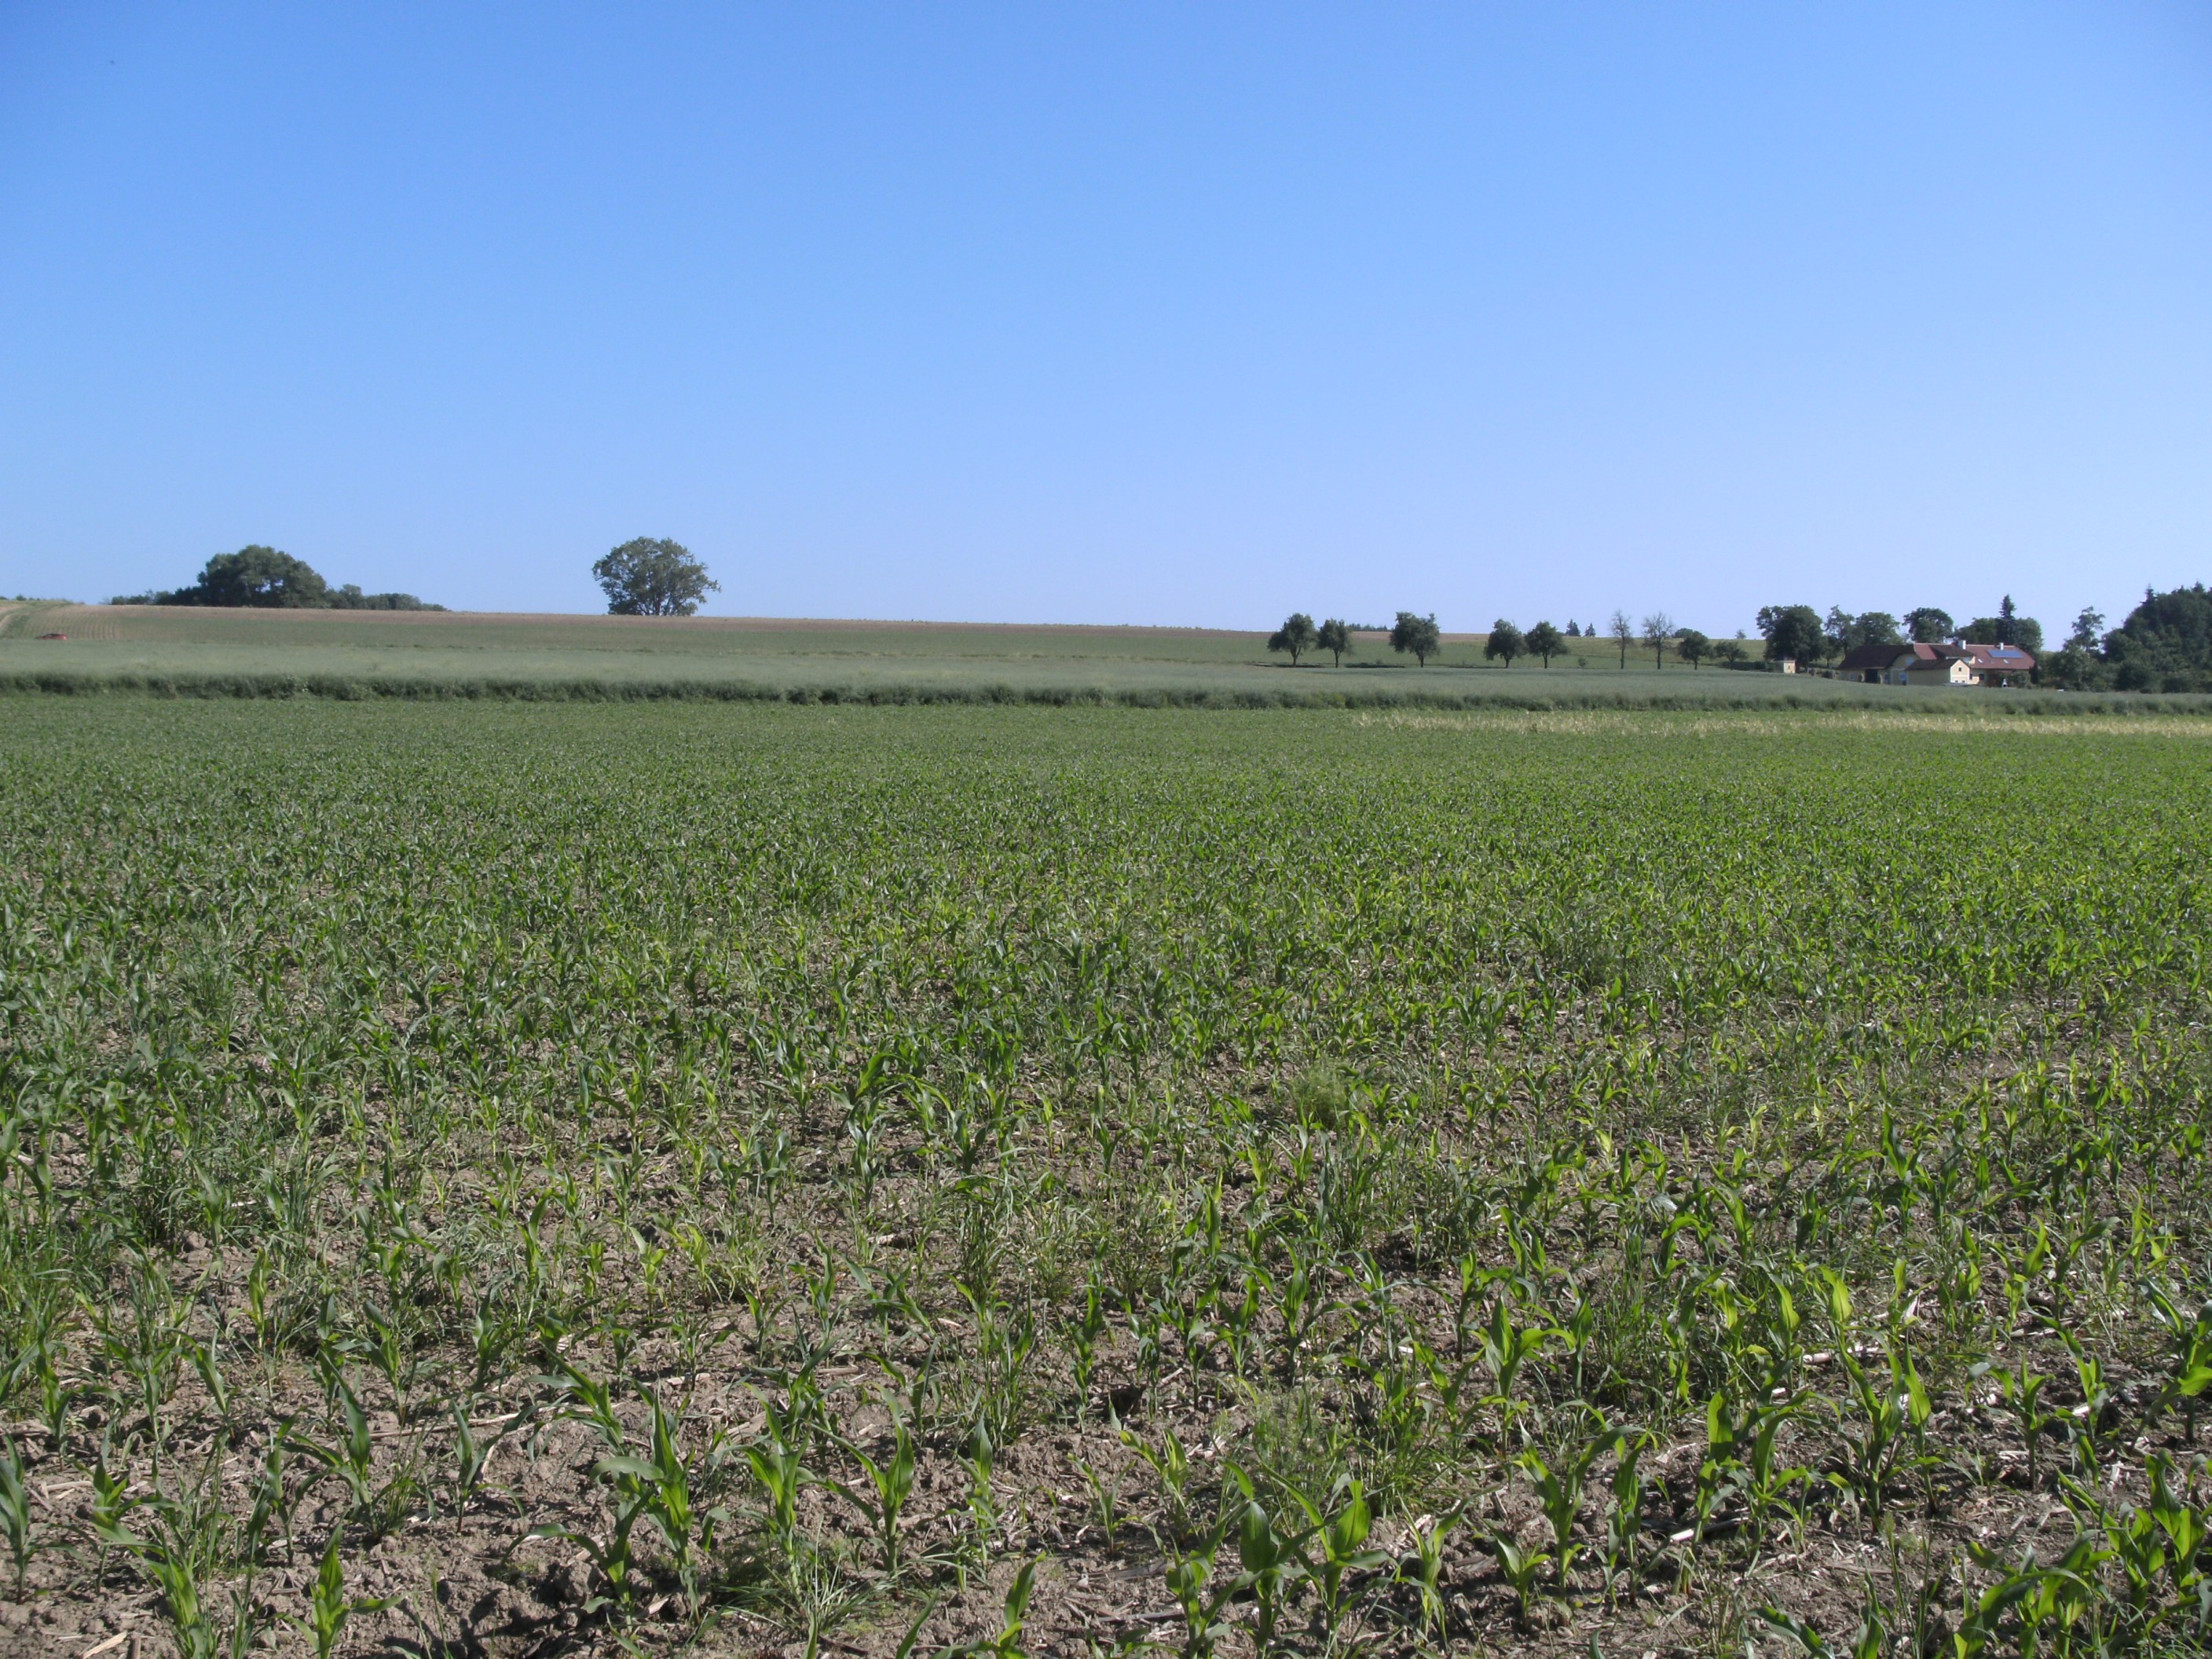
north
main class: Cropland
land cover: Maize
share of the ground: 25 - 50 %
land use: Agriculture (excluding fallow land and kitchen gardens)
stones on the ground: < 10 %
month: June
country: AT
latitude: 48.2032
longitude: 14.0498
